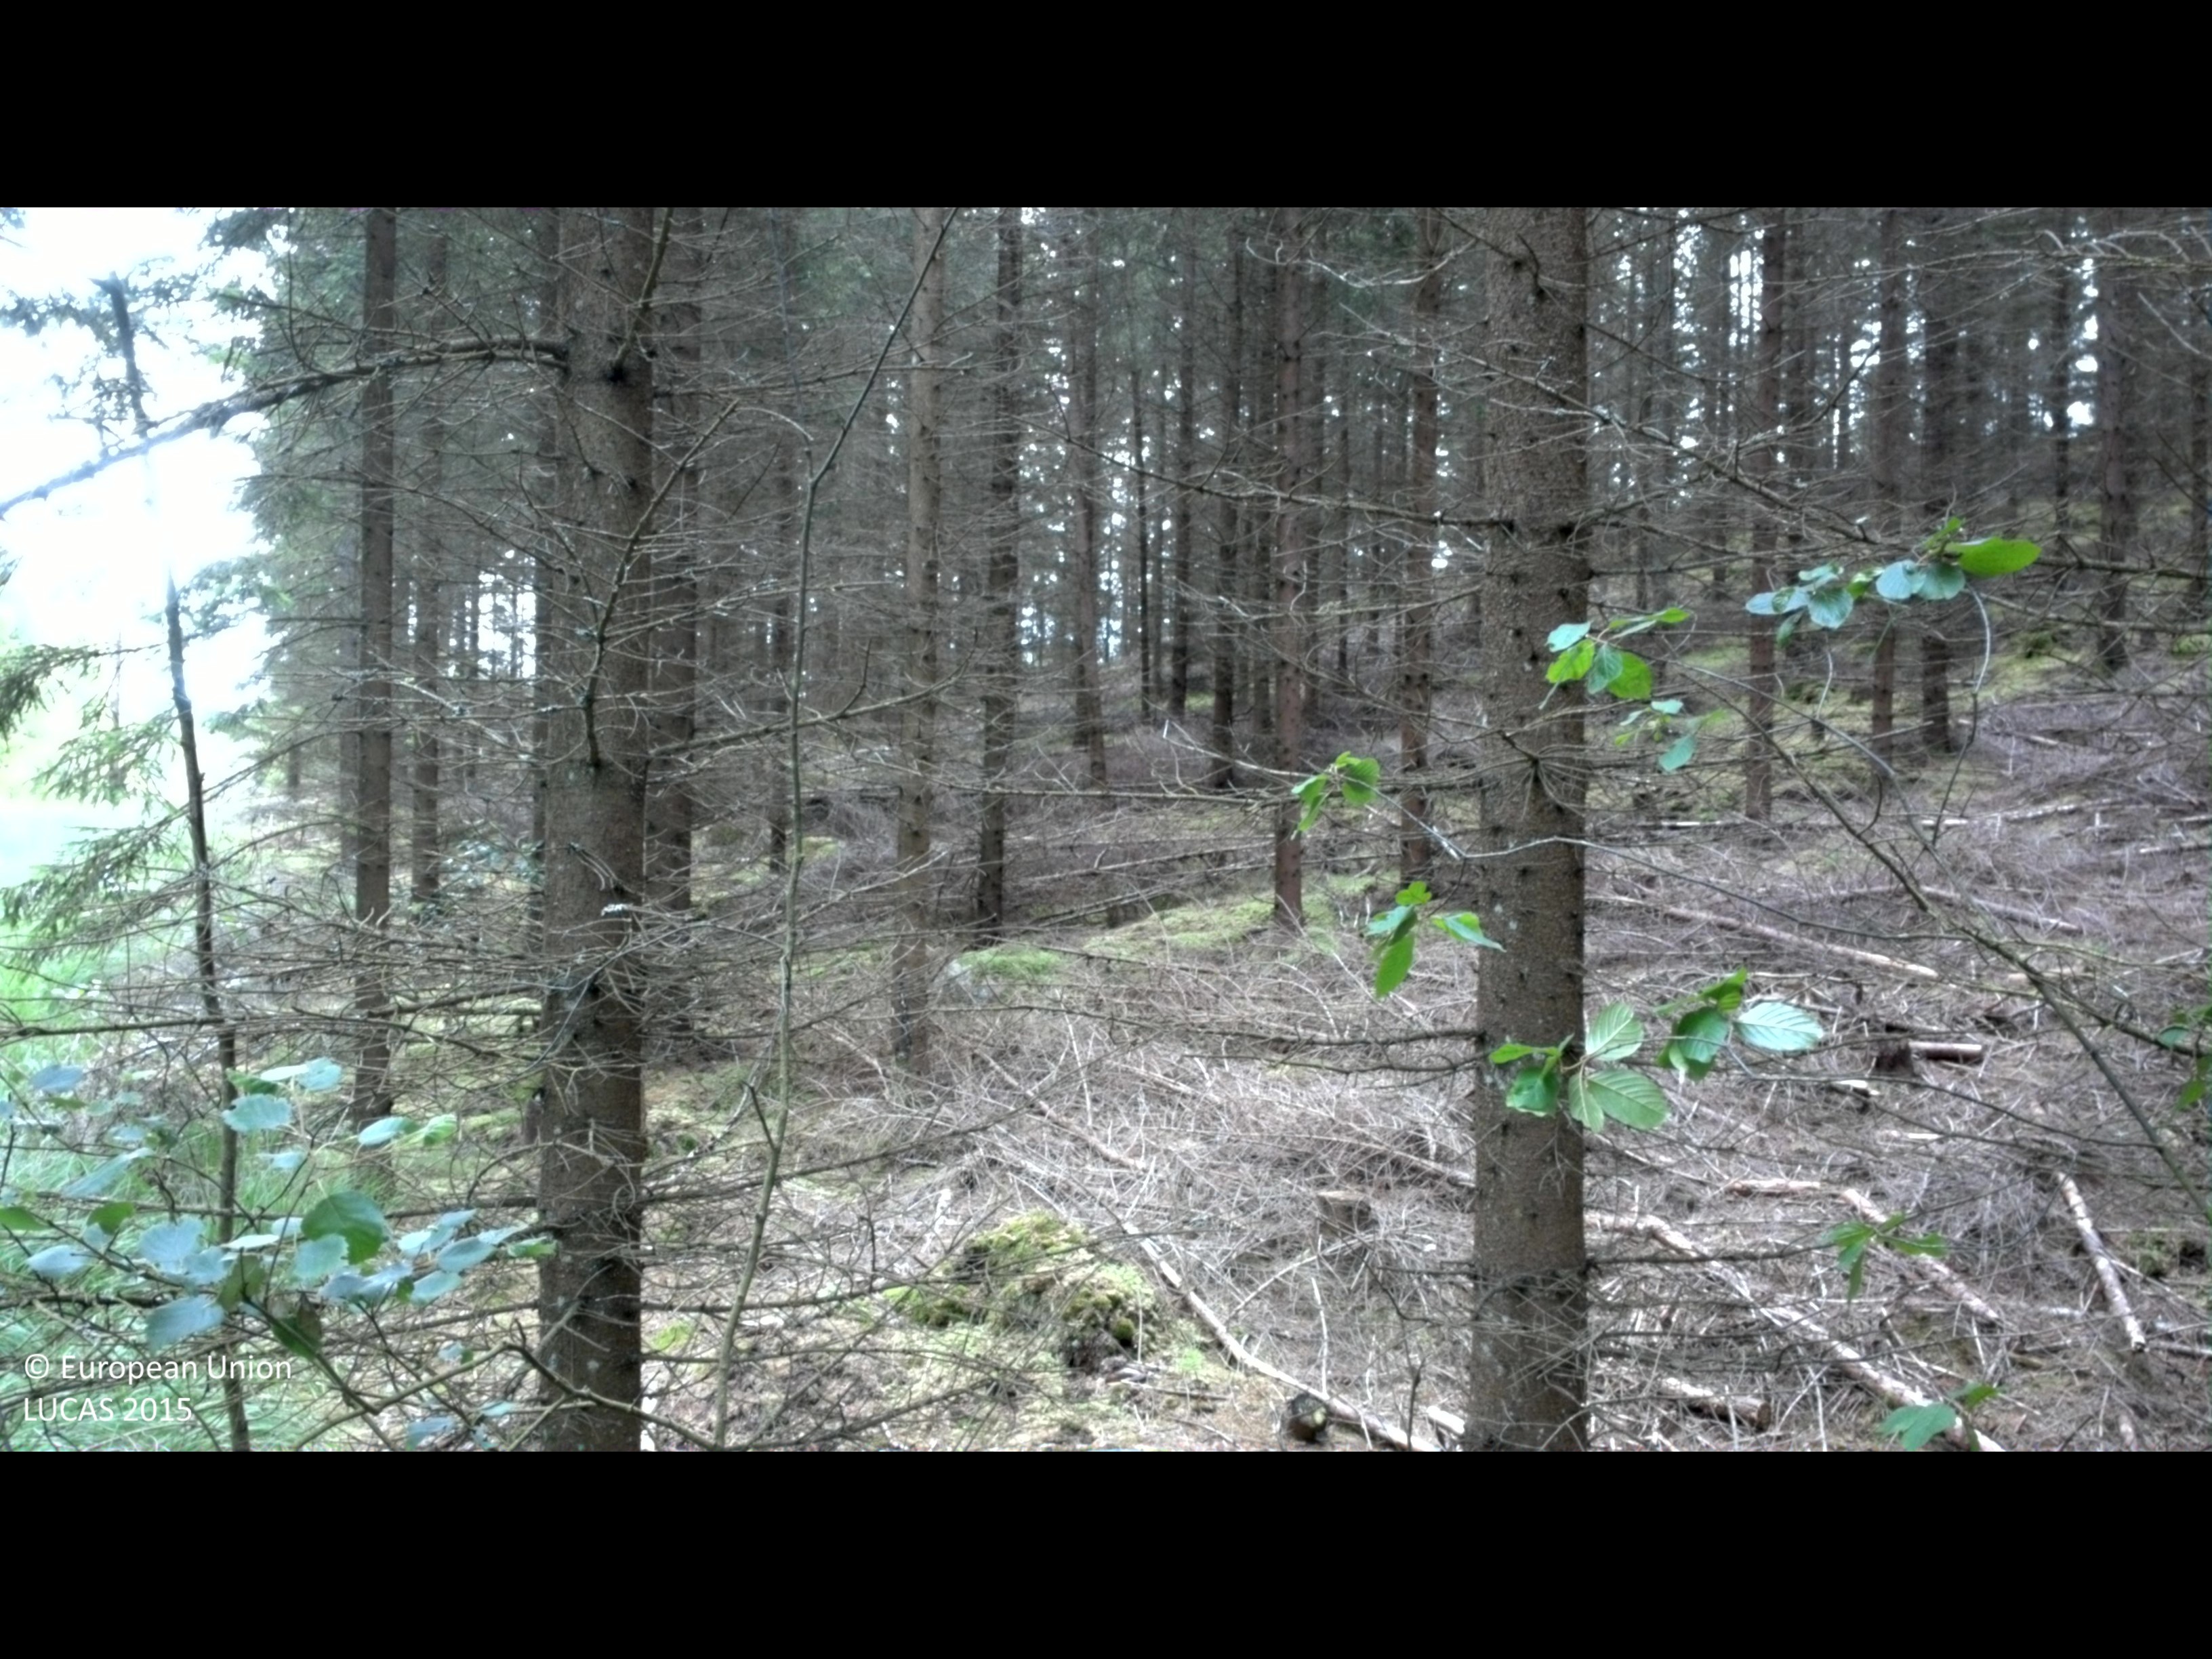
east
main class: Woodland
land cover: Spruce dominated coniferous woodland
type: boreal forest
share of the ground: > 75 %
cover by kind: coniferous forest trees 75 %, lichens and mosses 20 %
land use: Forestry
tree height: > 5 m
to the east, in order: Spruce dominated coniferous woodland; Tracks; Broadleaved woodland; Spruce dominated mixed woodland; Spruce dominated coniferous woodland; Ditches and canals; Spruce dominated mixed woodland; Grassland with sparse tree/shrub cover; Spruce dominated mixed woodland
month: August
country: SE
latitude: 56.6527
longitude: 13.8299
